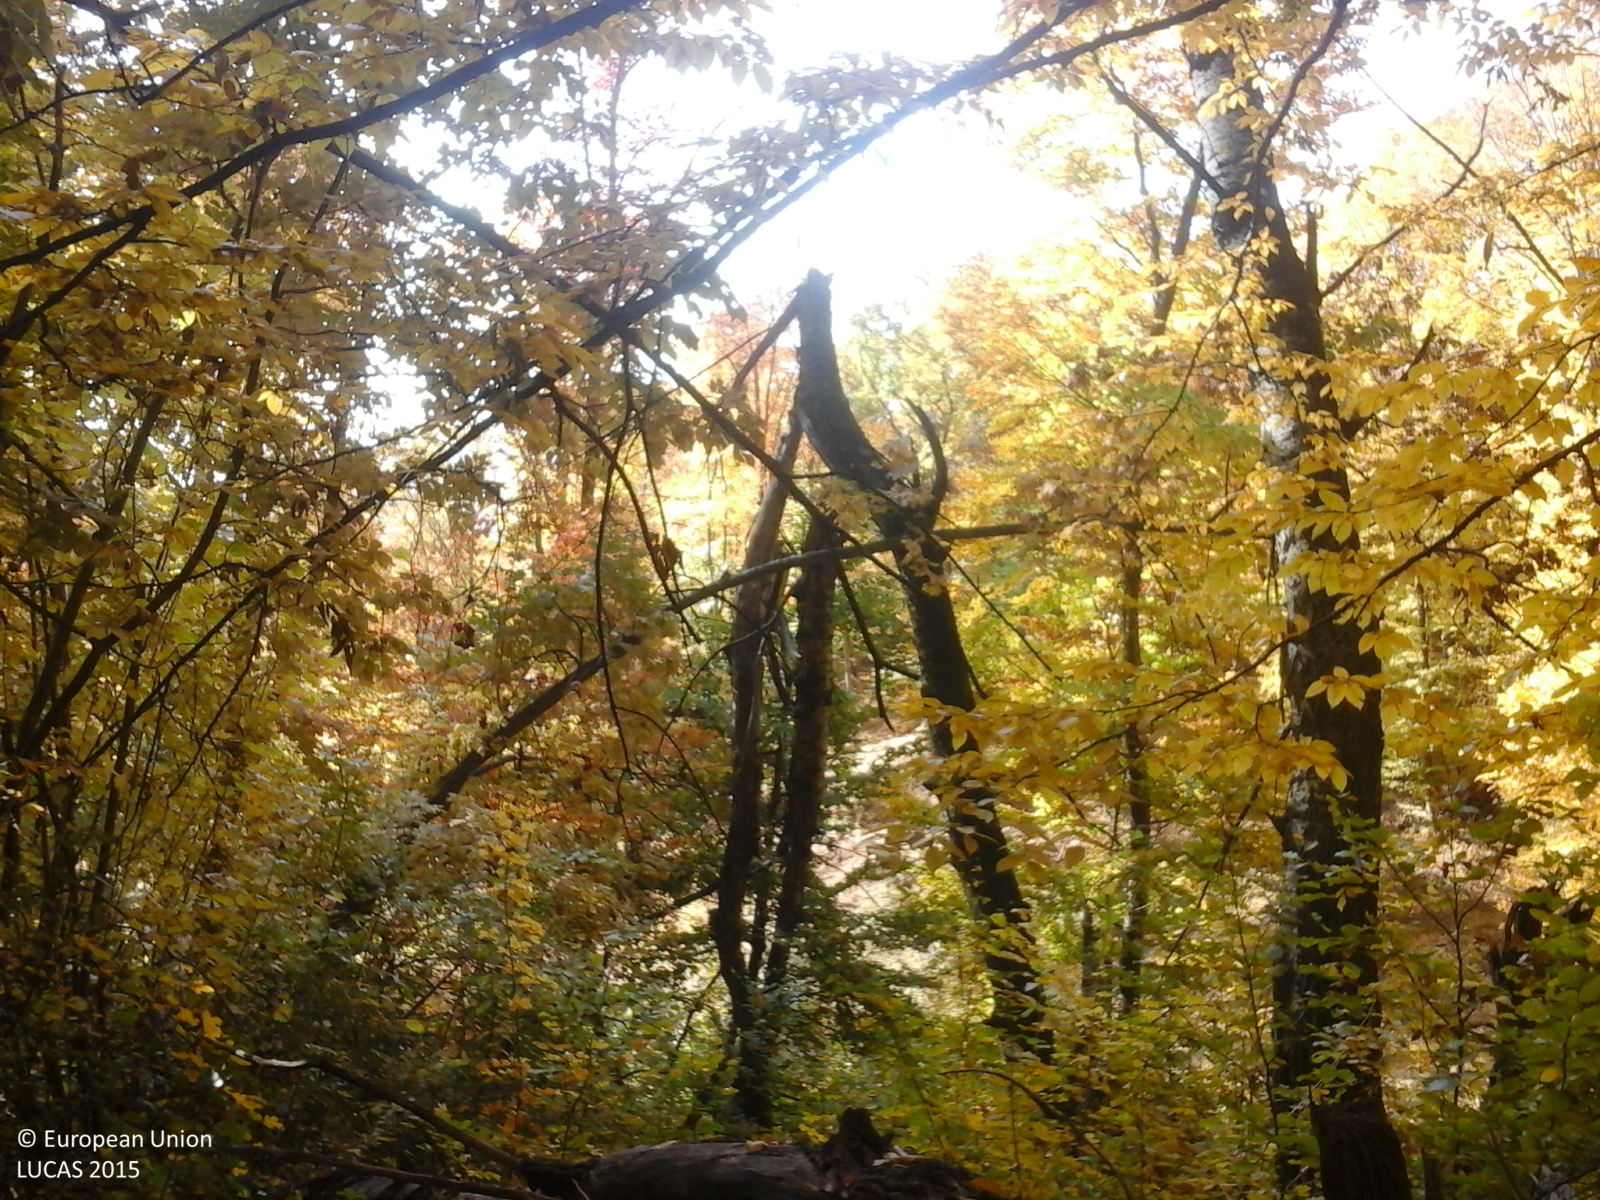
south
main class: Woodland
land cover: Broadleaved woodland
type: beech forest
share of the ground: > 75 %
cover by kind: broadleaved forest trees 100 %
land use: Forestry
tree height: > 5 m
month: October
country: RO
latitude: 45.6810
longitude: 26.9717
